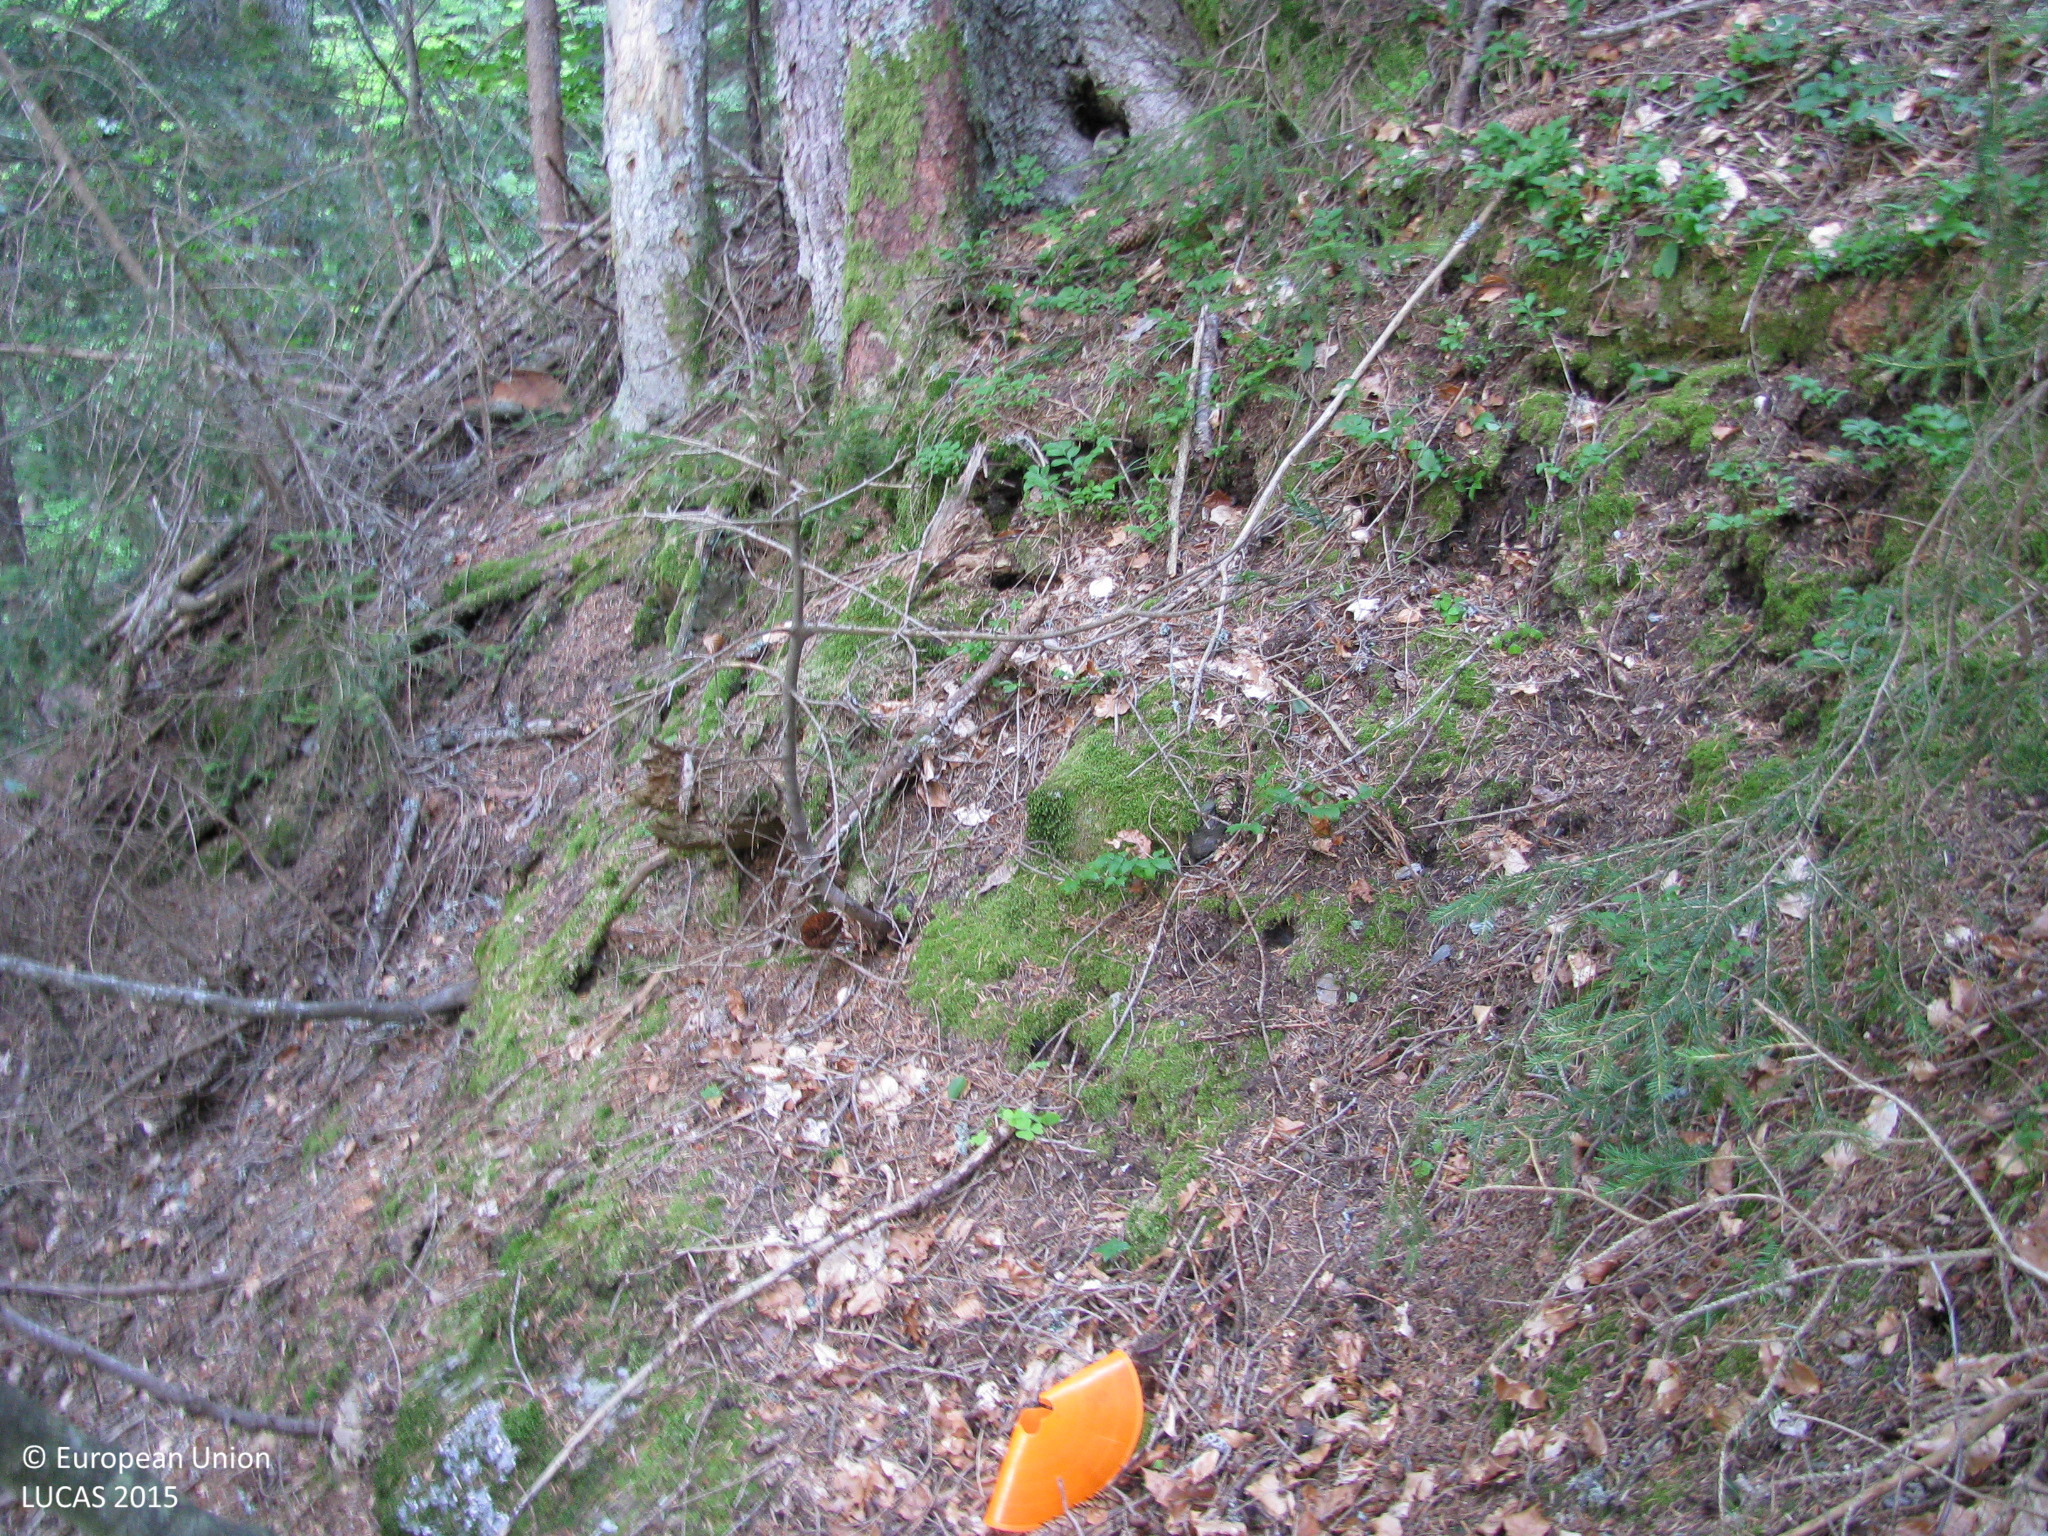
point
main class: Woodland
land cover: Other coniferous woodland
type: alpine coniferous forest
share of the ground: > 75 %
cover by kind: coniferous forest trees 75 %, broadleaved forest trees 15 %, herbaceous plants 10 %
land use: Forestry
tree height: > 5 m
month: July
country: AT
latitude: 46.6741
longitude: 12.8340
